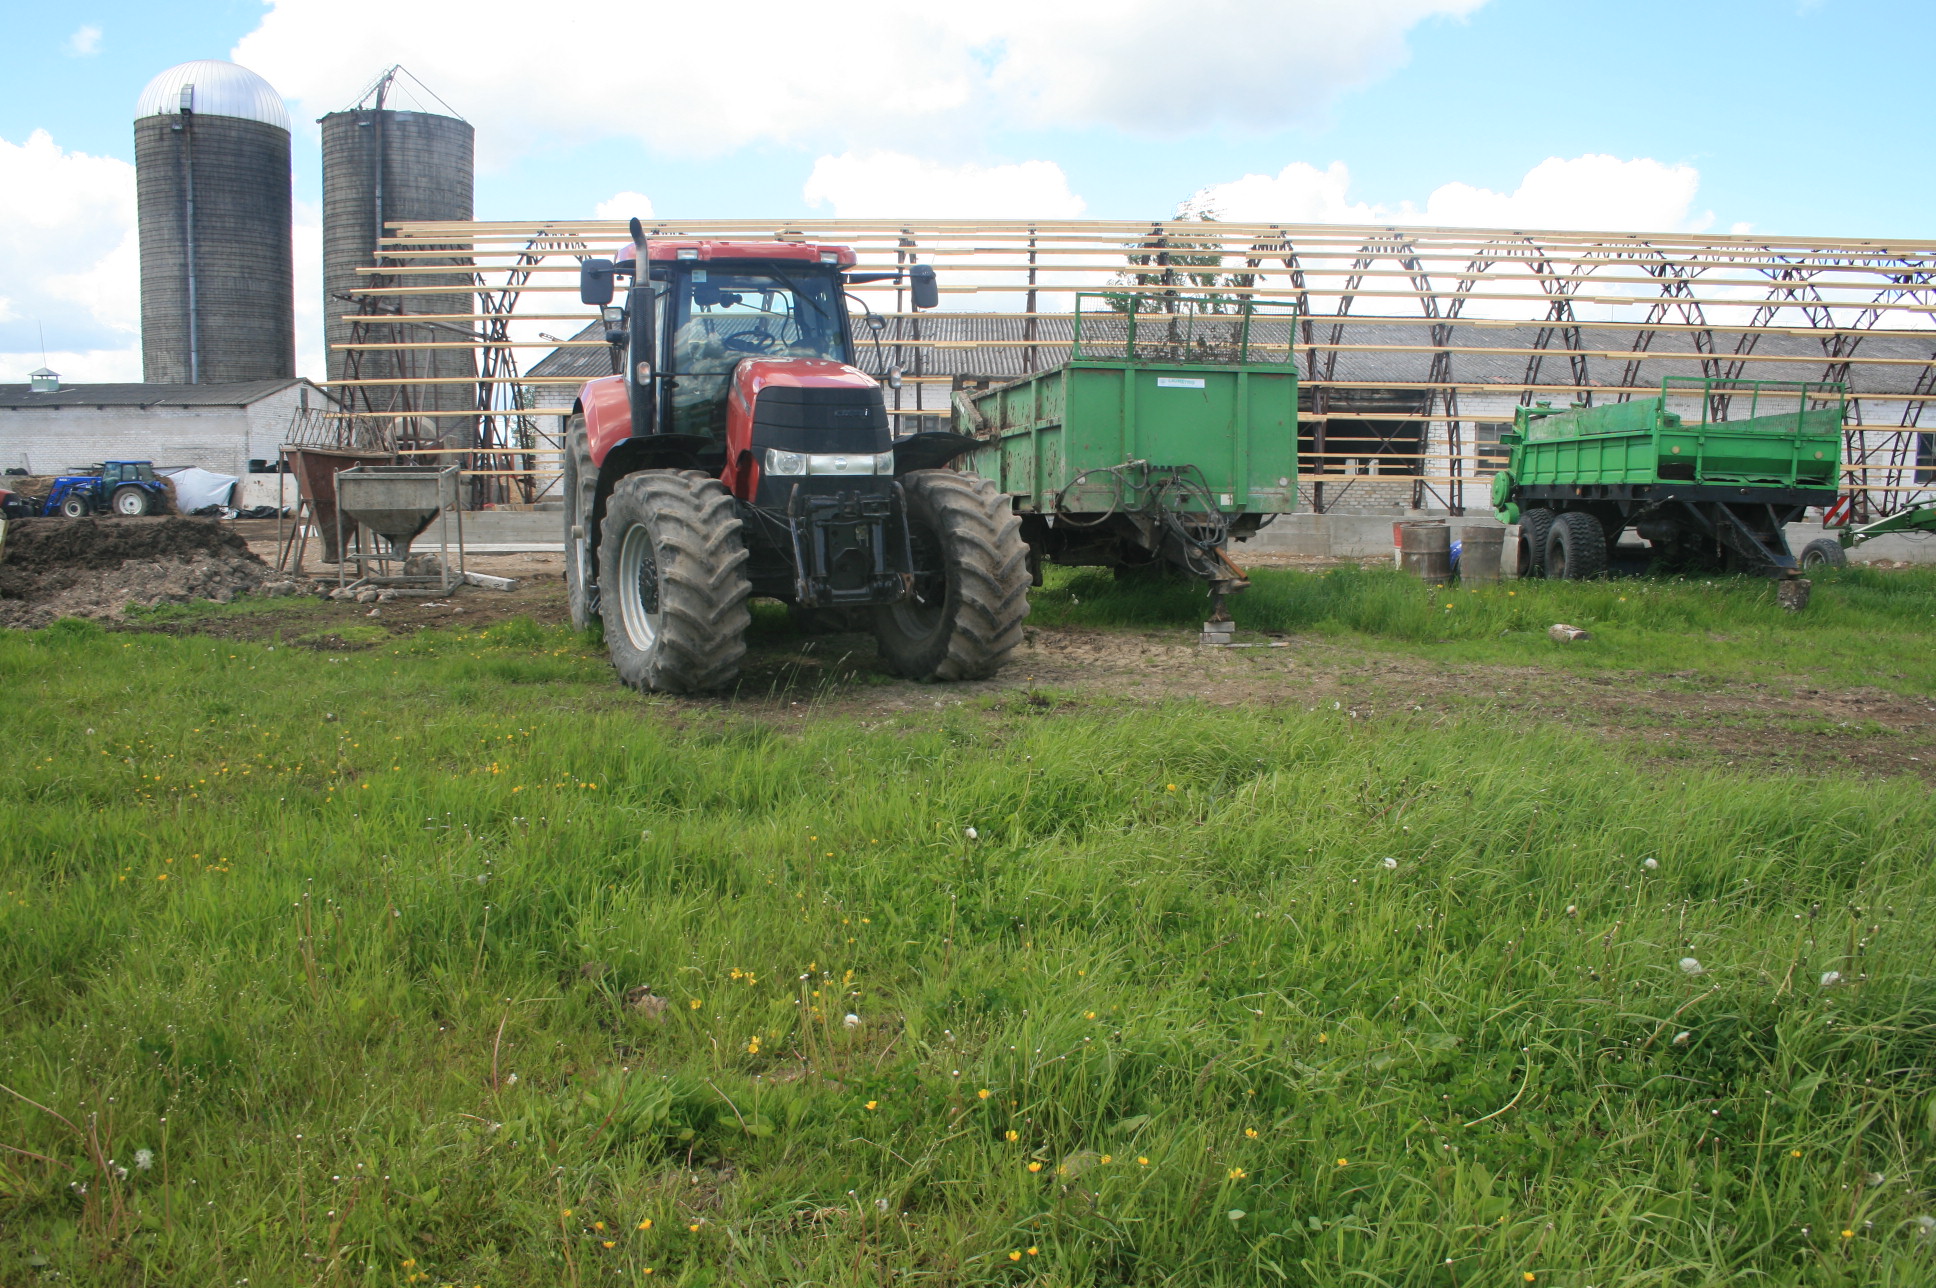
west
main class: Grassland
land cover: Grassland without tree/shrub cover
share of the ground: > 75 %
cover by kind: herbaceous plants 100 %
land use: Agriculture (excluding fallow land and kitchen gardens)
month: May
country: LT
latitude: 55.9919
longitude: 22.3204
